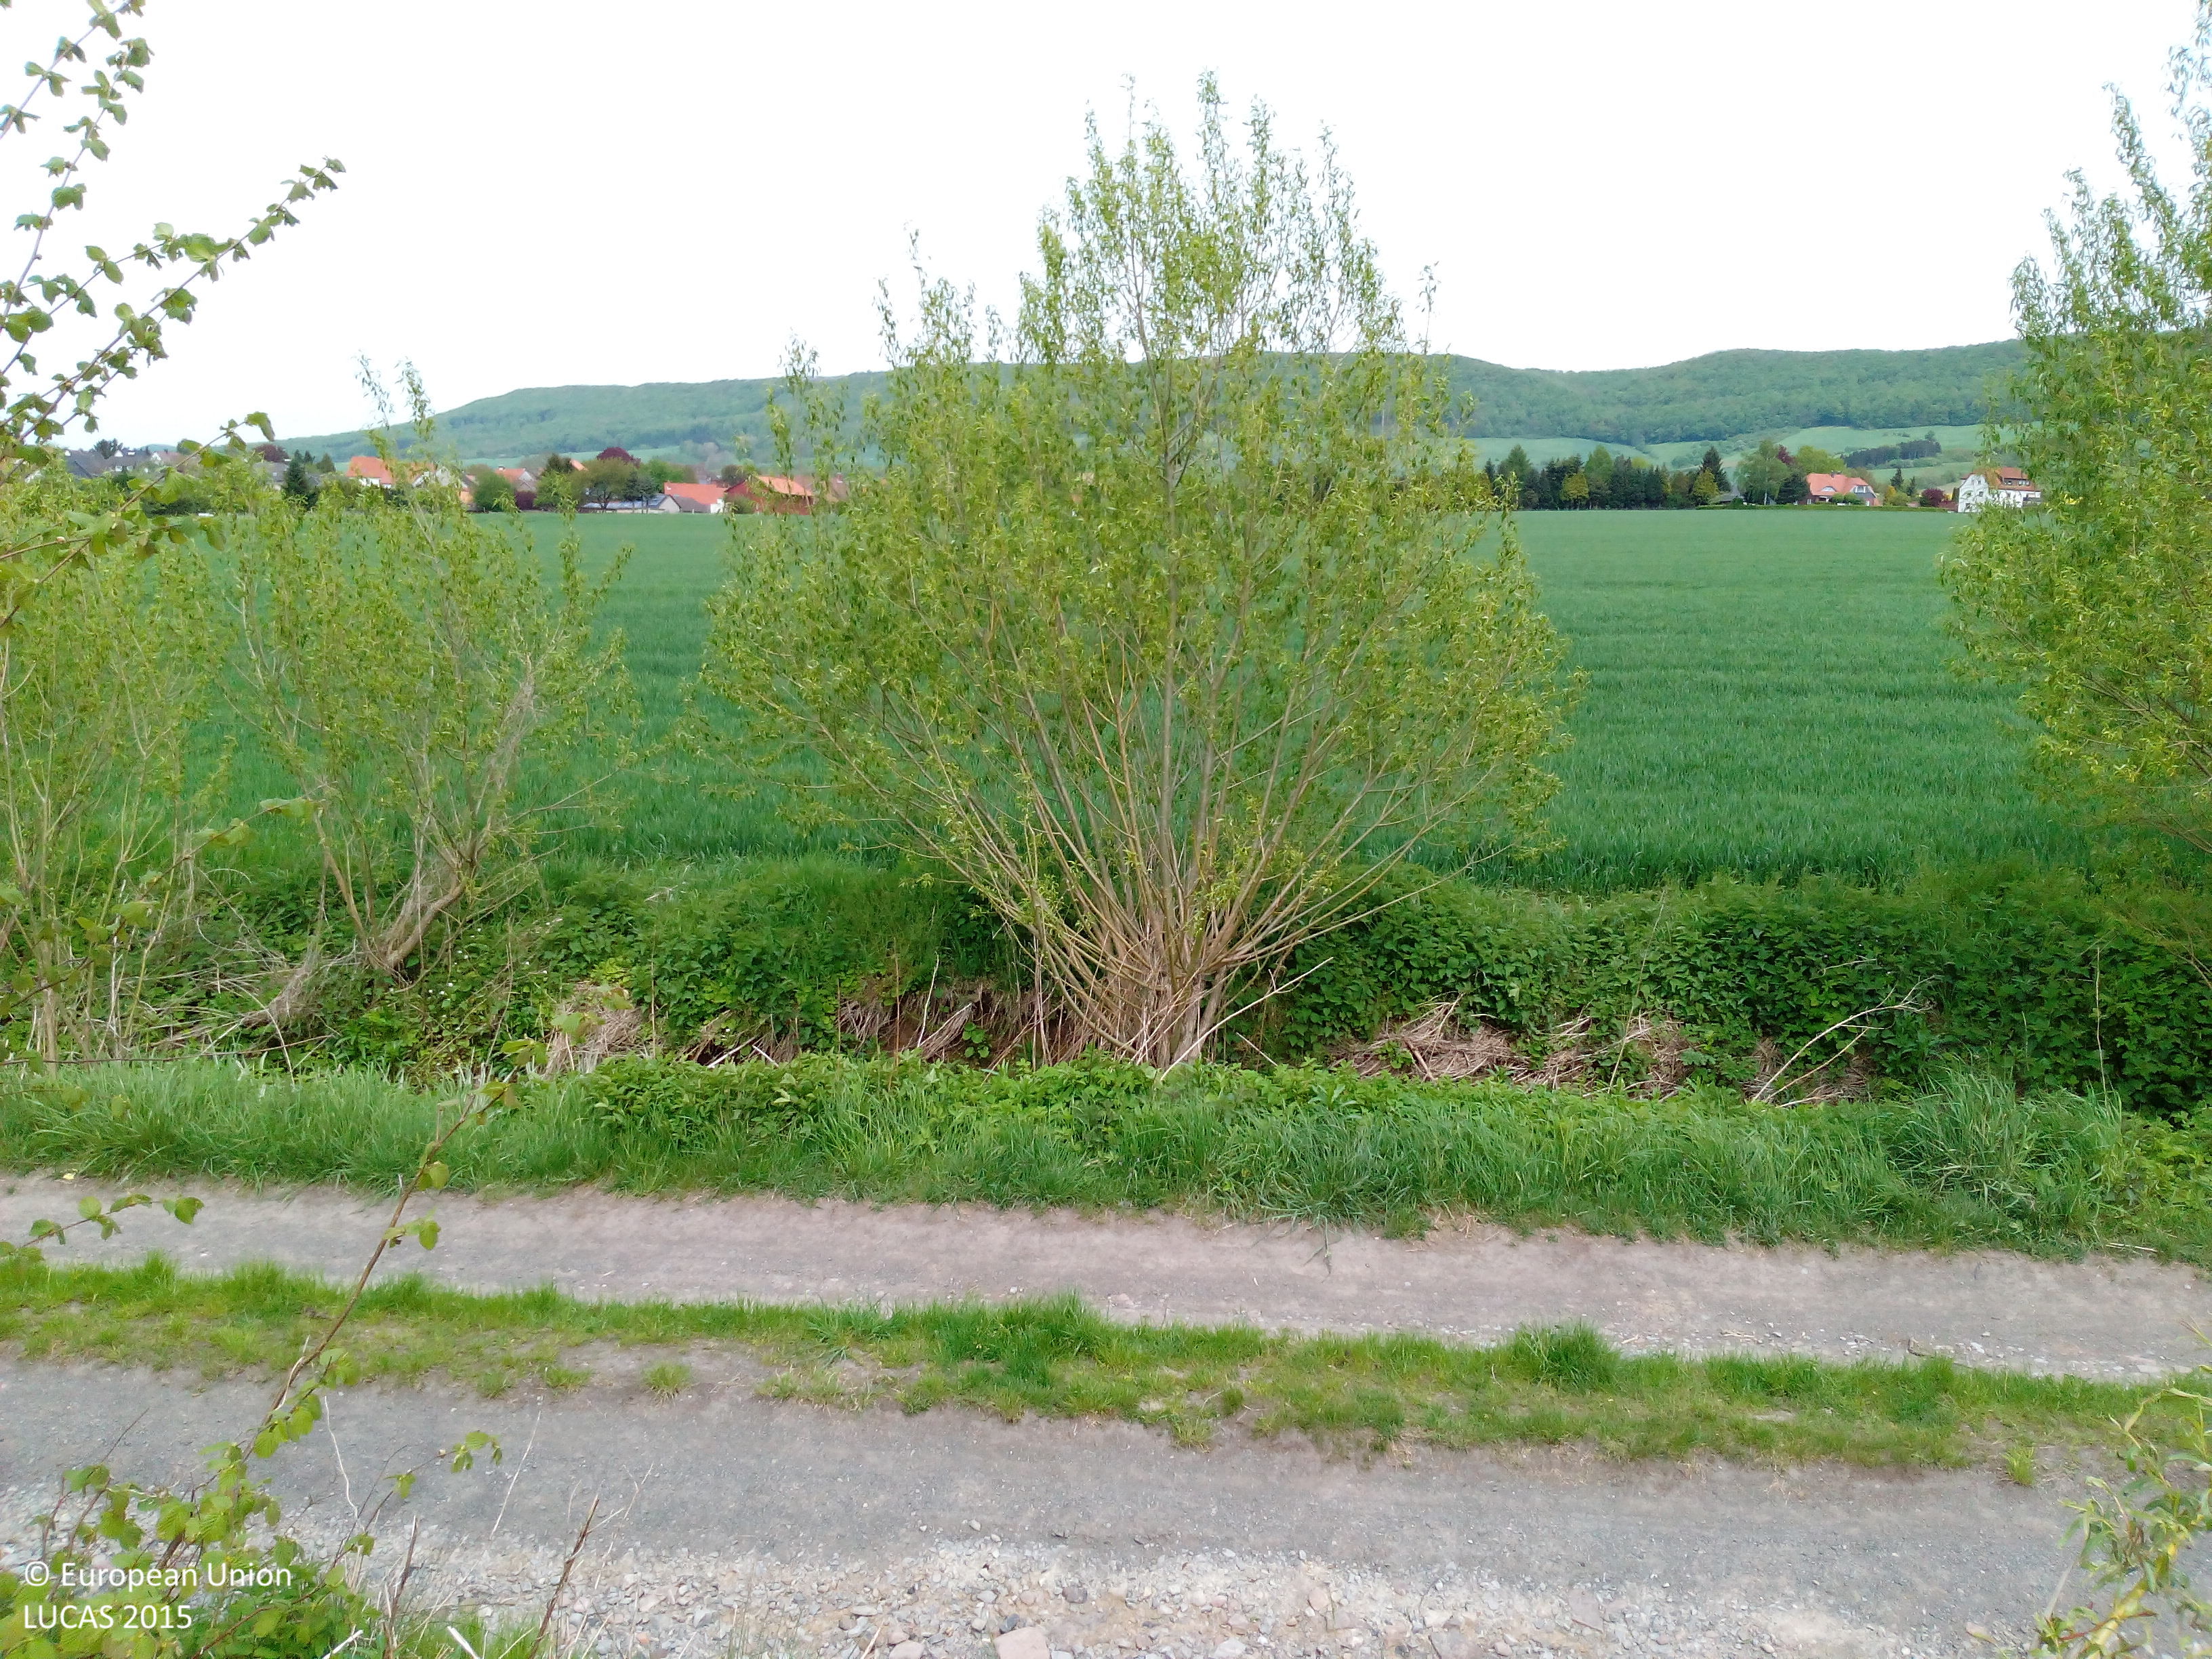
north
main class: Cropland
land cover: Triticale
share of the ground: > 75 %
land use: Agriculture (excluding fallow land and kitchen gardens)
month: May
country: DE
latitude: 51.9634
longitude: 9.6072
